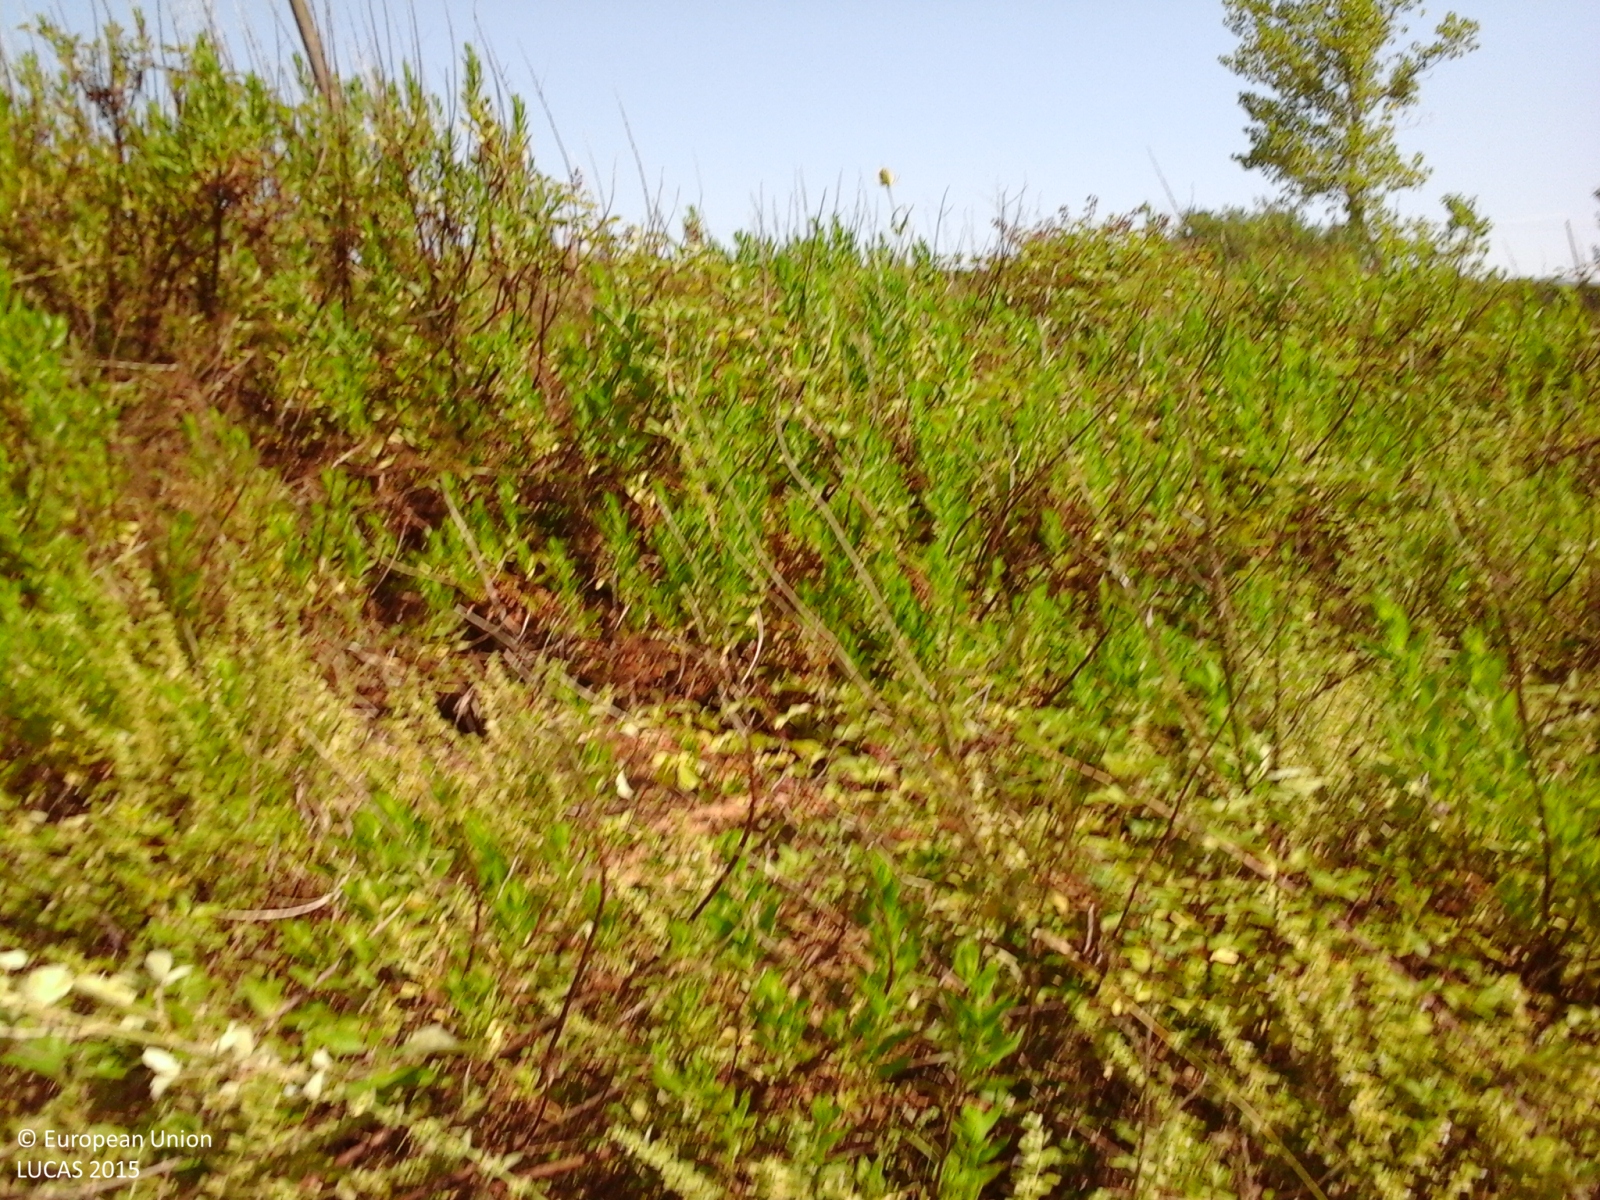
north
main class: Grassland
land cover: Spontaneously vegetated surfaces
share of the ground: > 75 %
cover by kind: herbaceous plants 85 %, shrubs 5 %, consolidated bare surface 5 %, unconsolidated bare surface 5 %
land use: Abandoned areas
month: July
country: IT
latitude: 42.9735
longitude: 11.0634
